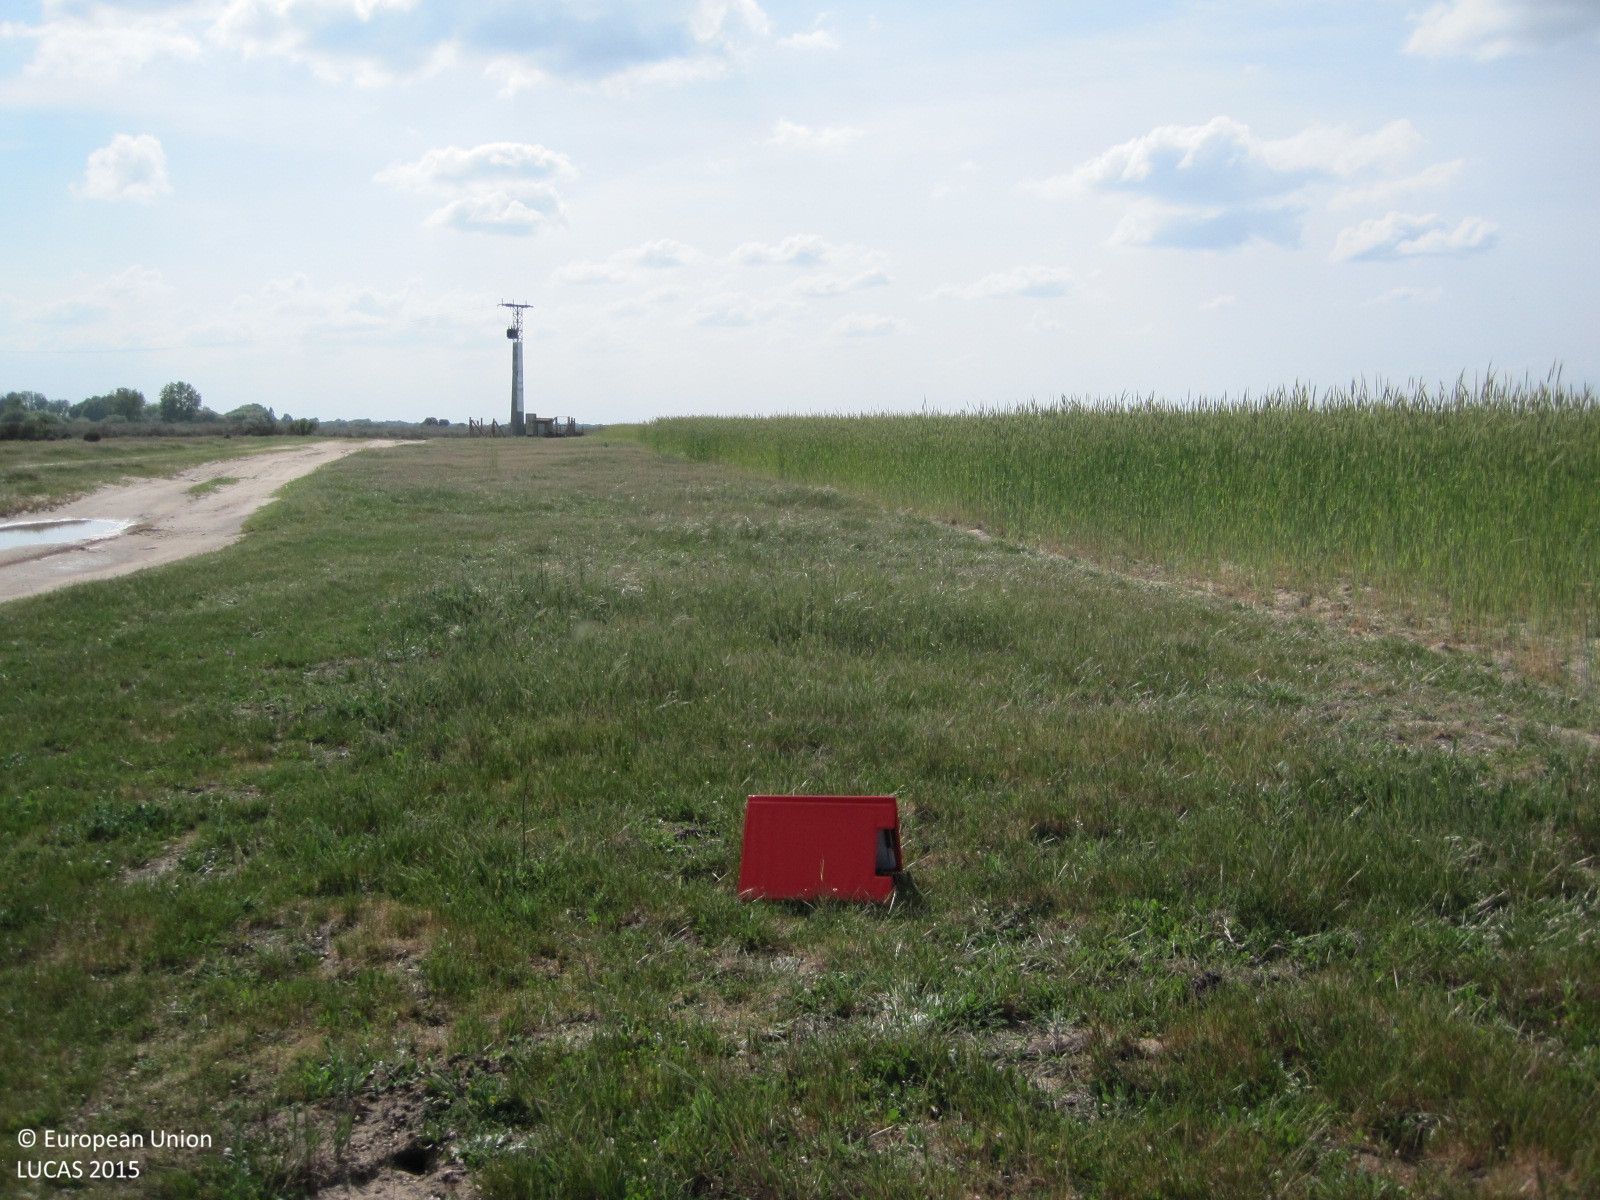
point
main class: Grassland
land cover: Grassland without tree/shrub cover
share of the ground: > 75 %
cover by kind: herbaceous plants 100 %
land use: Agriculture (excluding fallow land and kitchen gardens)
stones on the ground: 10 - 25 %
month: April
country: ES
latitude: 40.0087
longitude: -4.9873
